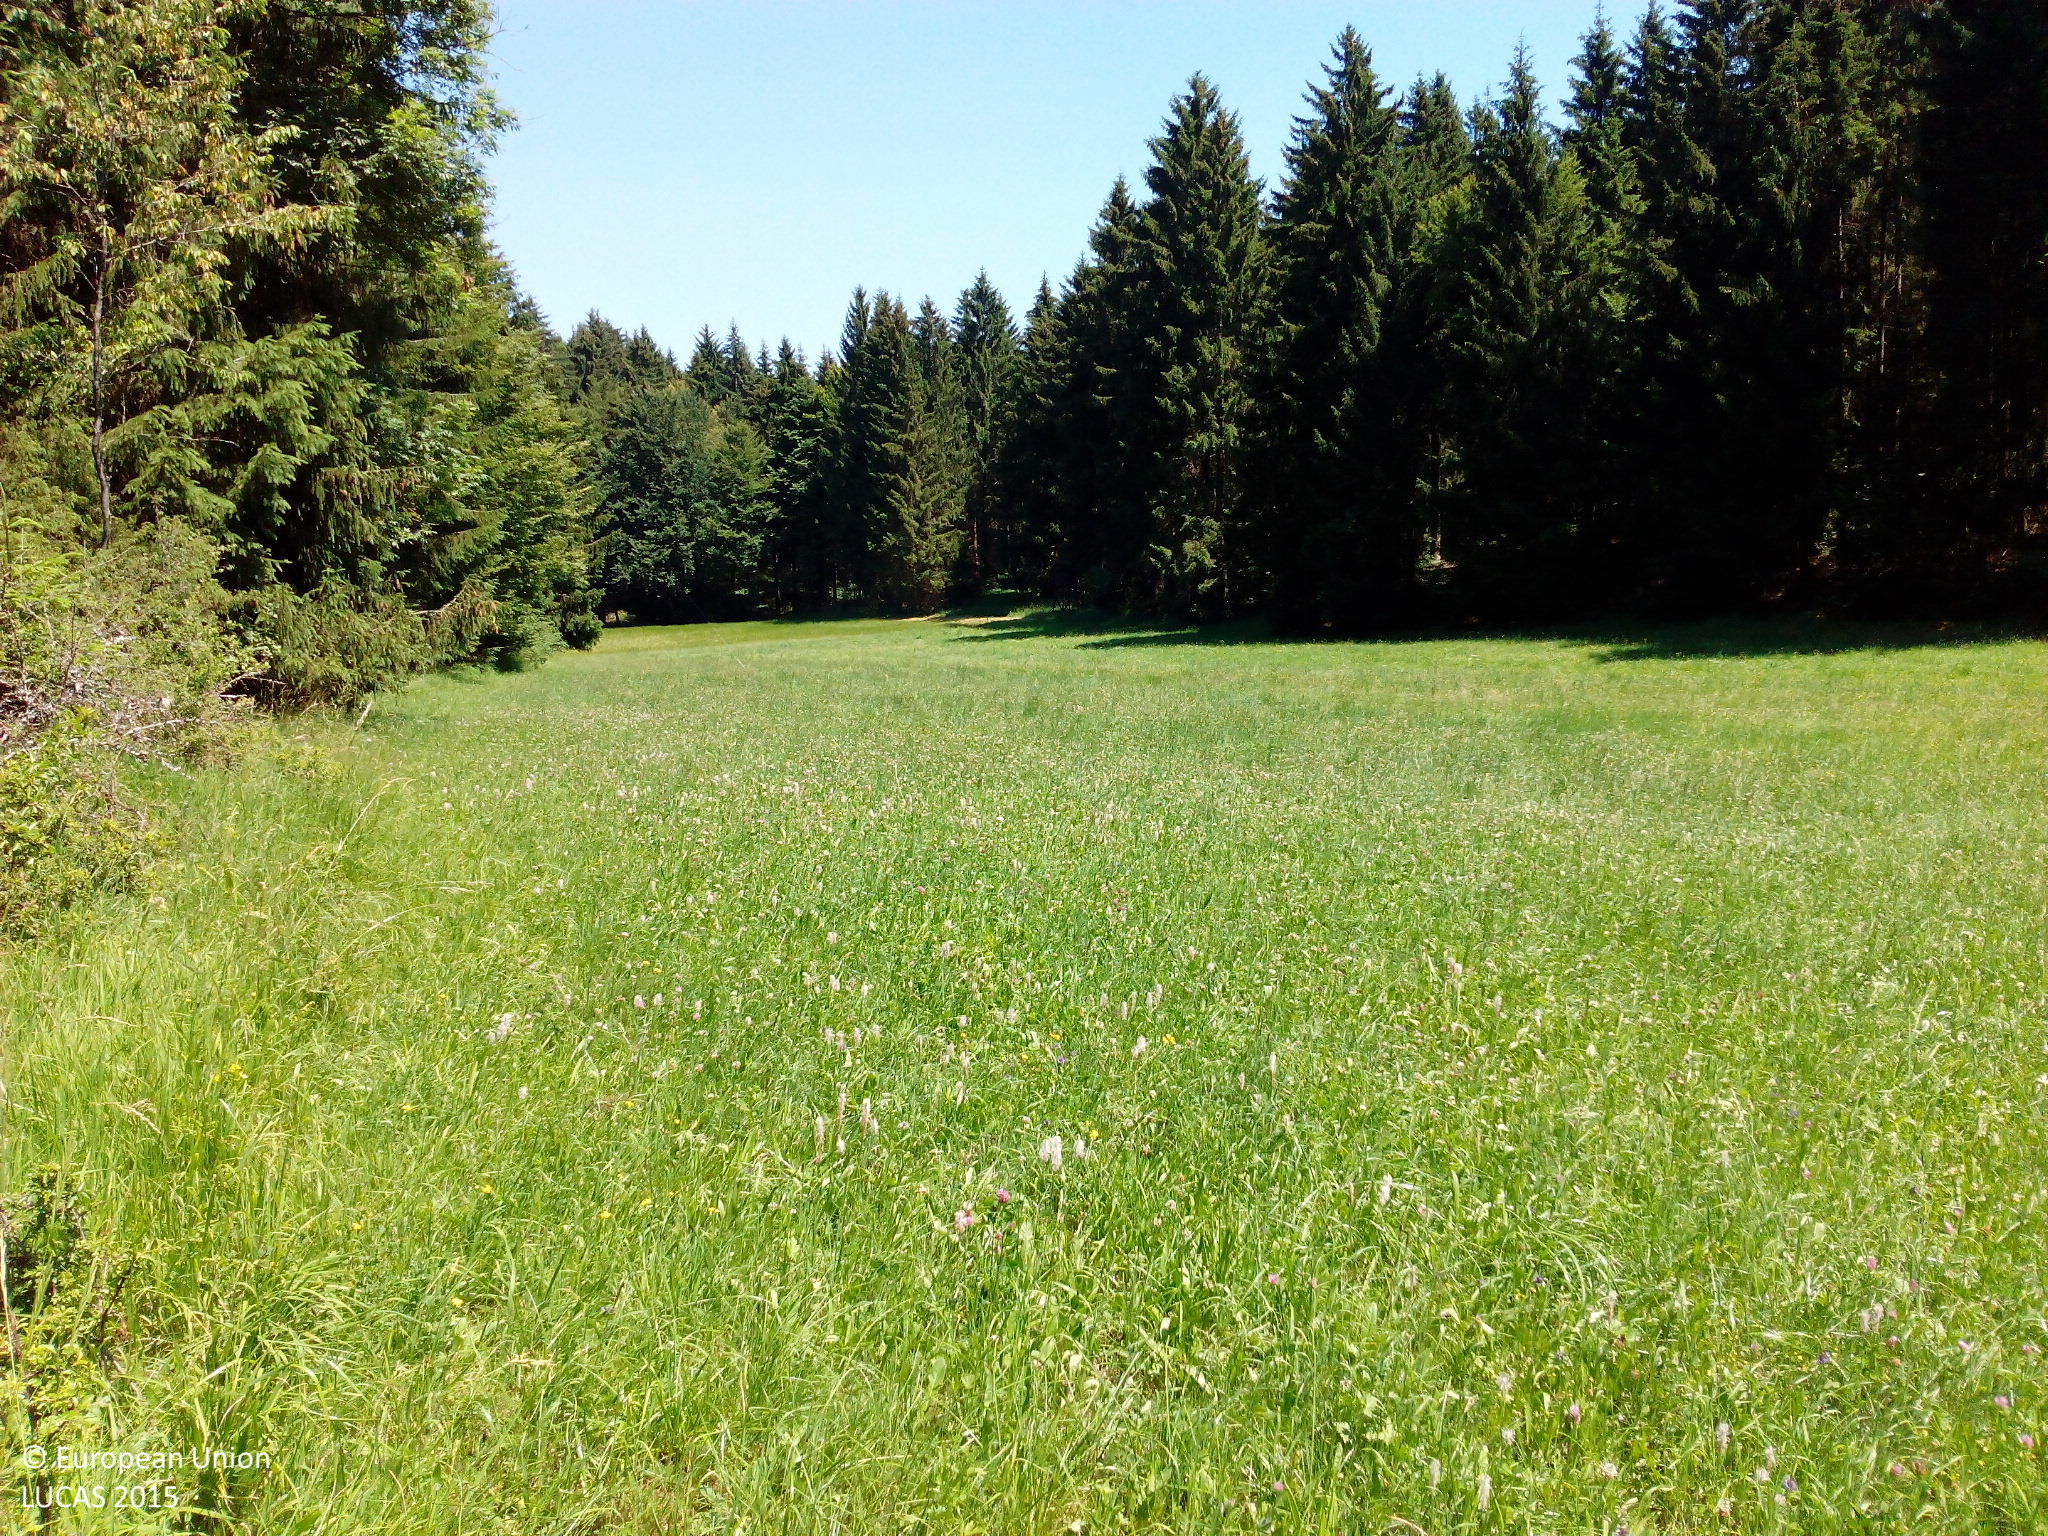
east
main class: Shrubland
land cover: Shrubland with sparse tree cover
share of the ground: 25 - 50 %
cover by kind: herbaceous plants 60 %, shrubs 35 %, coniferous forest trees 5 %
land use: Agriculture (excluding fallow land and kitchen gardens)
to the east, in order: Shrubland with sparse tree cover; Grassland without tree/shrub cover; Spruce dominated coniferous woodland
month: July
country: DE
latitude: 48.3478
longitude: 9.3932
